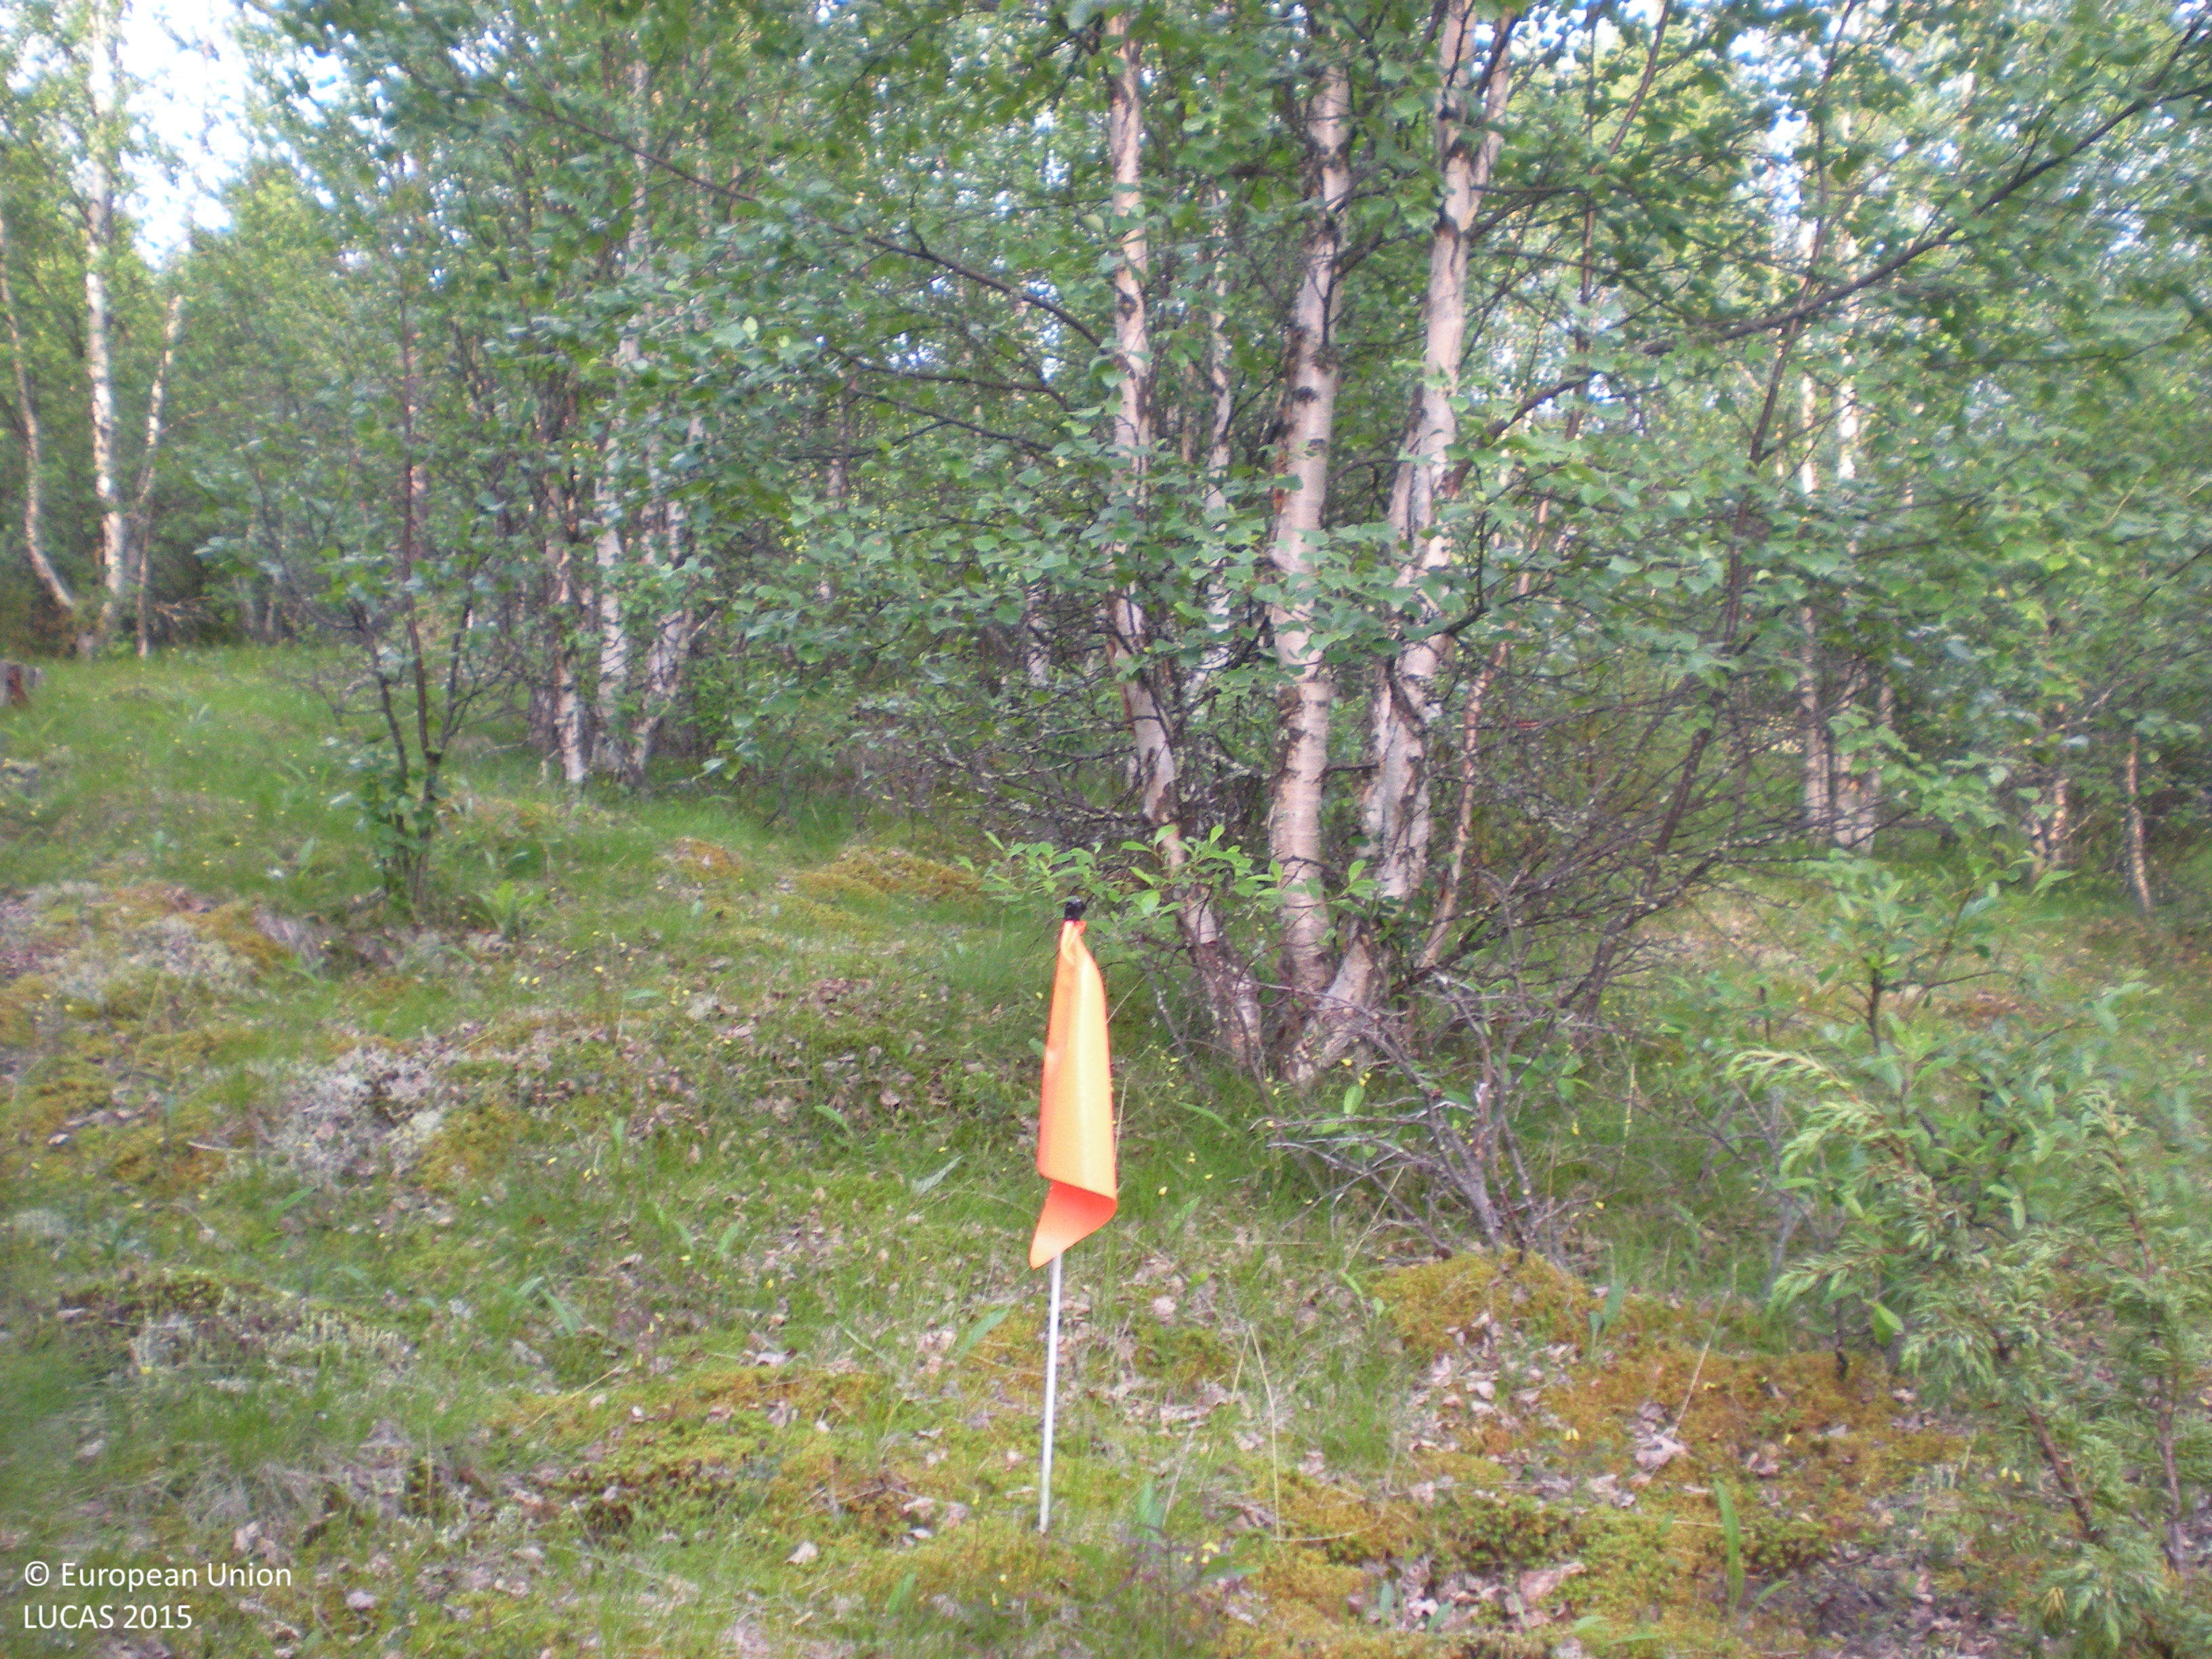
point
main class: Woodland
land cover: Broadleaved woodland
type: boreal forest
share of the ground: 50 - 75 %
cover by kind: broadleaved forest trees 70 %, lichens and mosses 15 %, herbaceous plants 10 %, shrubs 5 %
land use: Forestry
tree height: > 5 m
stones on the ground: > 50 %
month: July
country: SE
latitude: 65.6097
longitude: 17.7066
